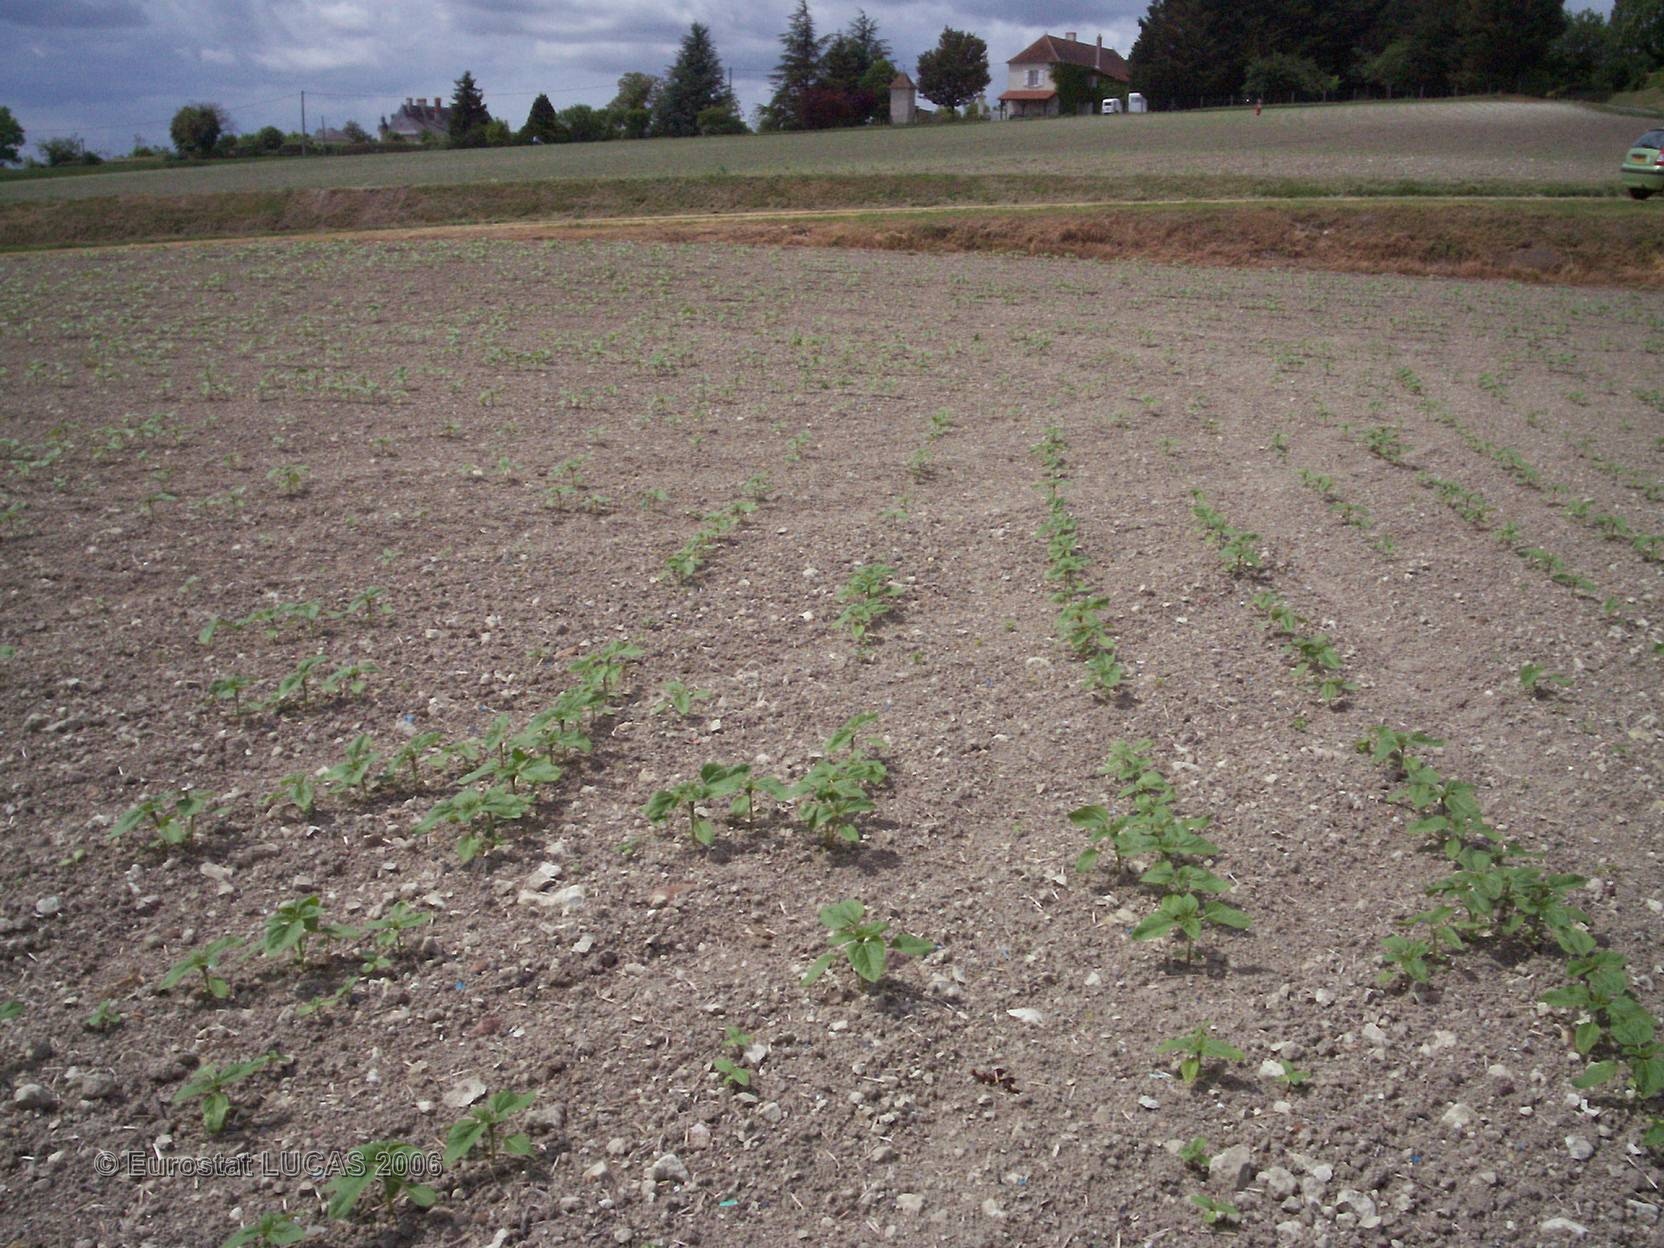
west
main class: Cropland
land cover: Sunflower
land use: Agriculture (excluding fallow land and kitchen gardens)
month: May
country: FR
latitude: 46.8272
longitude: 0.4241
